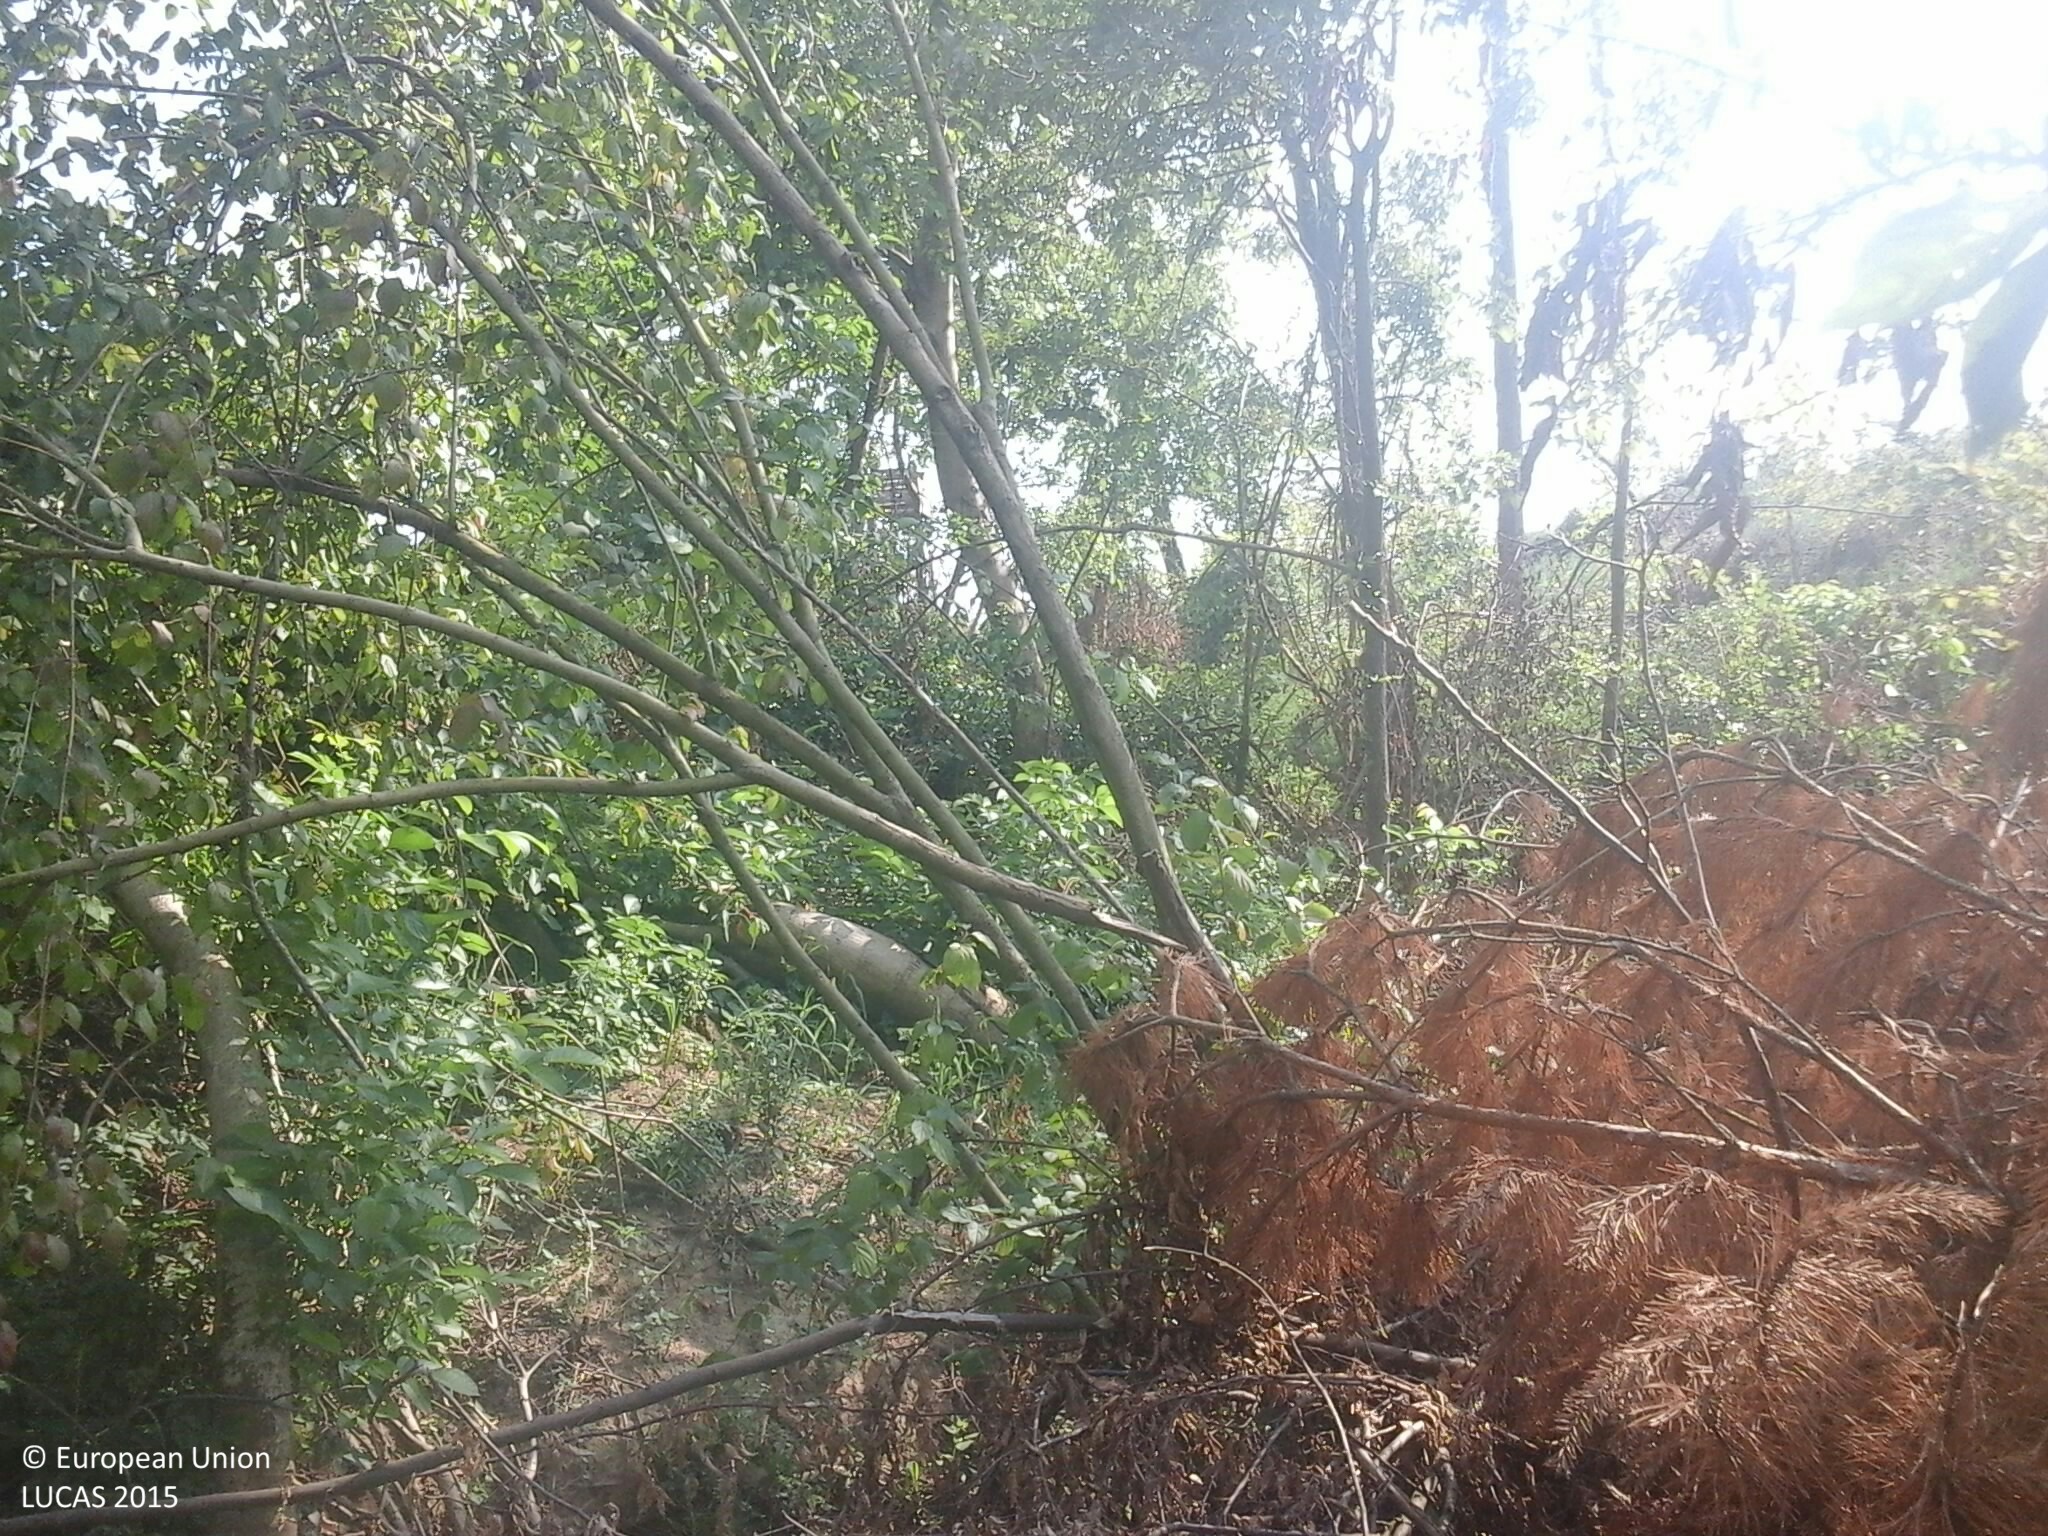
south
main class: Woodland
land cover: Broadleaved woodland
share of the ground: 50 - 75 %
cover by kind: broadleaved forest trees 50 %, shrubs 50 %
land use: Forestry
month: August
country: HU
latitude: 45.9576
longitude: 18.2775
